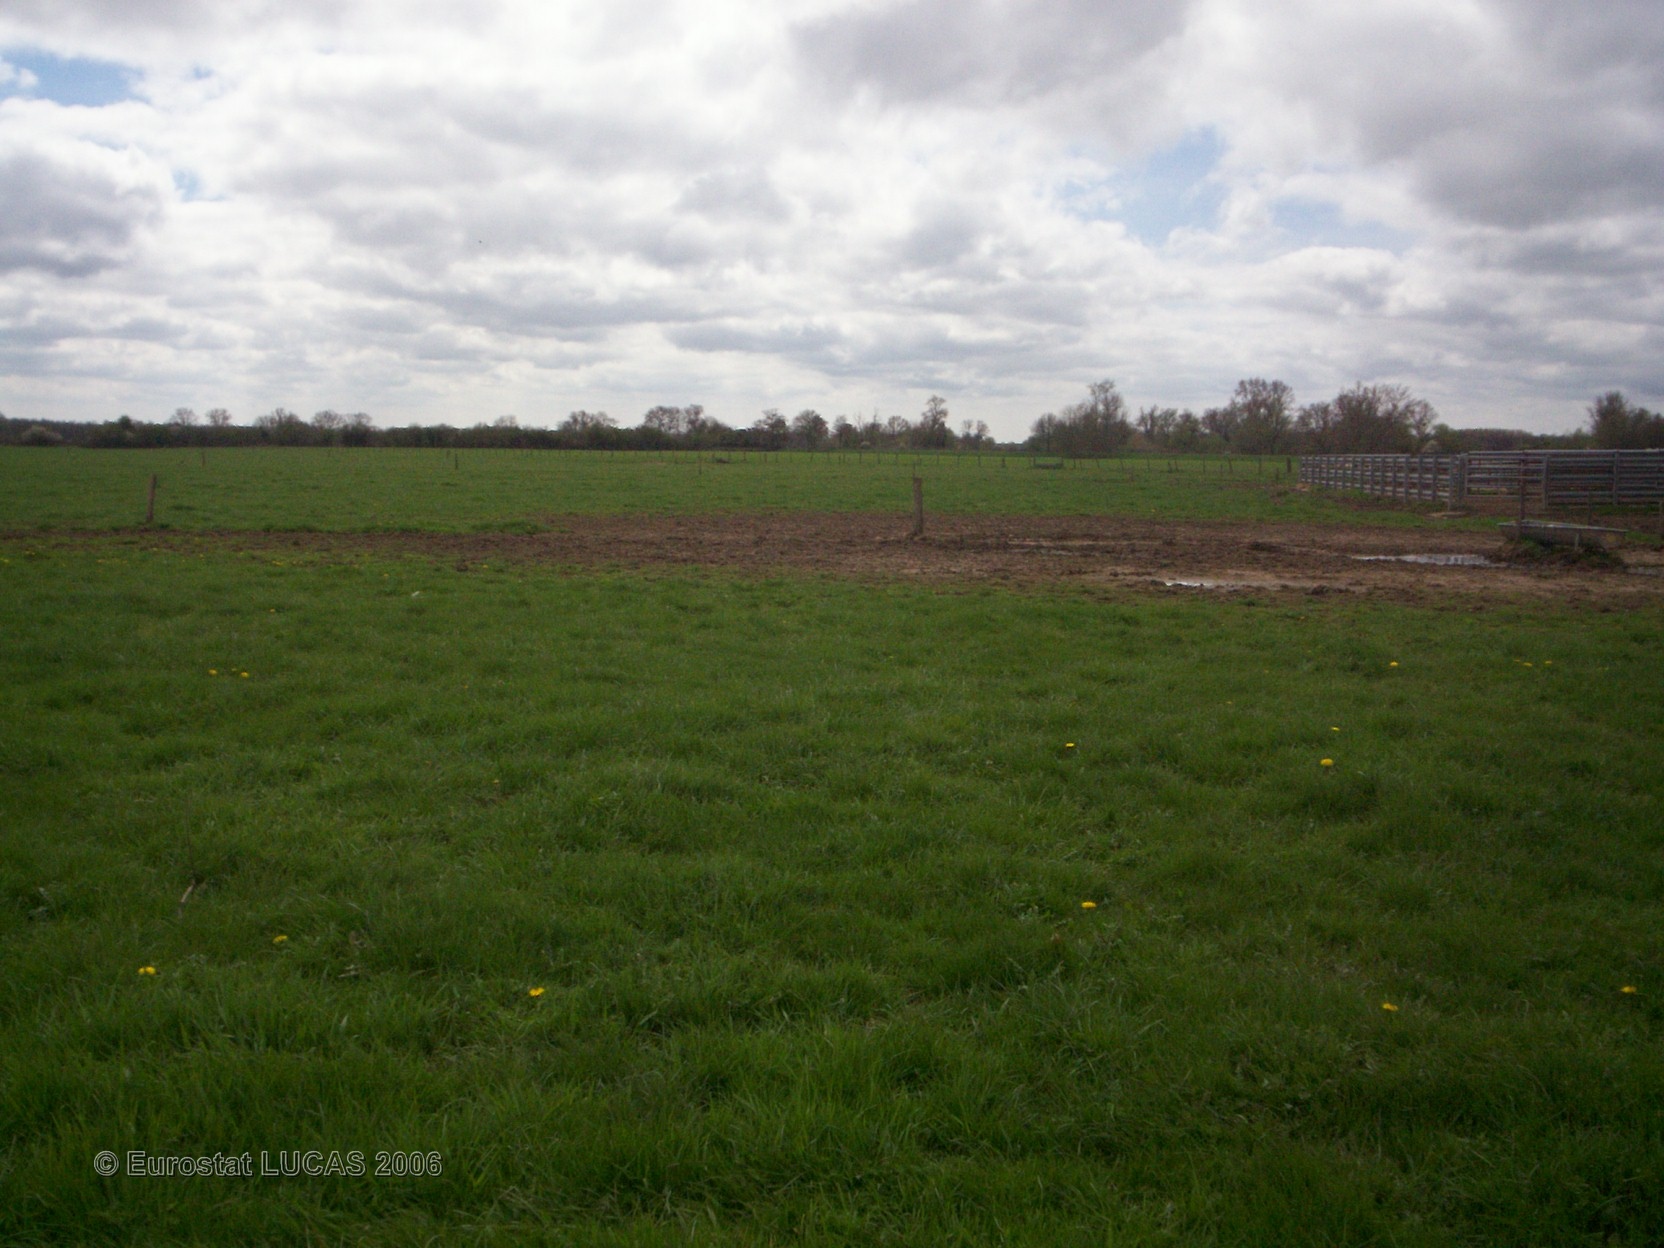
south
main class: Grassland
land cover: Grassland without tree/shrub cover
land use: Agriculture (excluding fallow land and kitchen gardens)
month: April
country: FR
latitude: 46.7931
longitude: 3.0399
